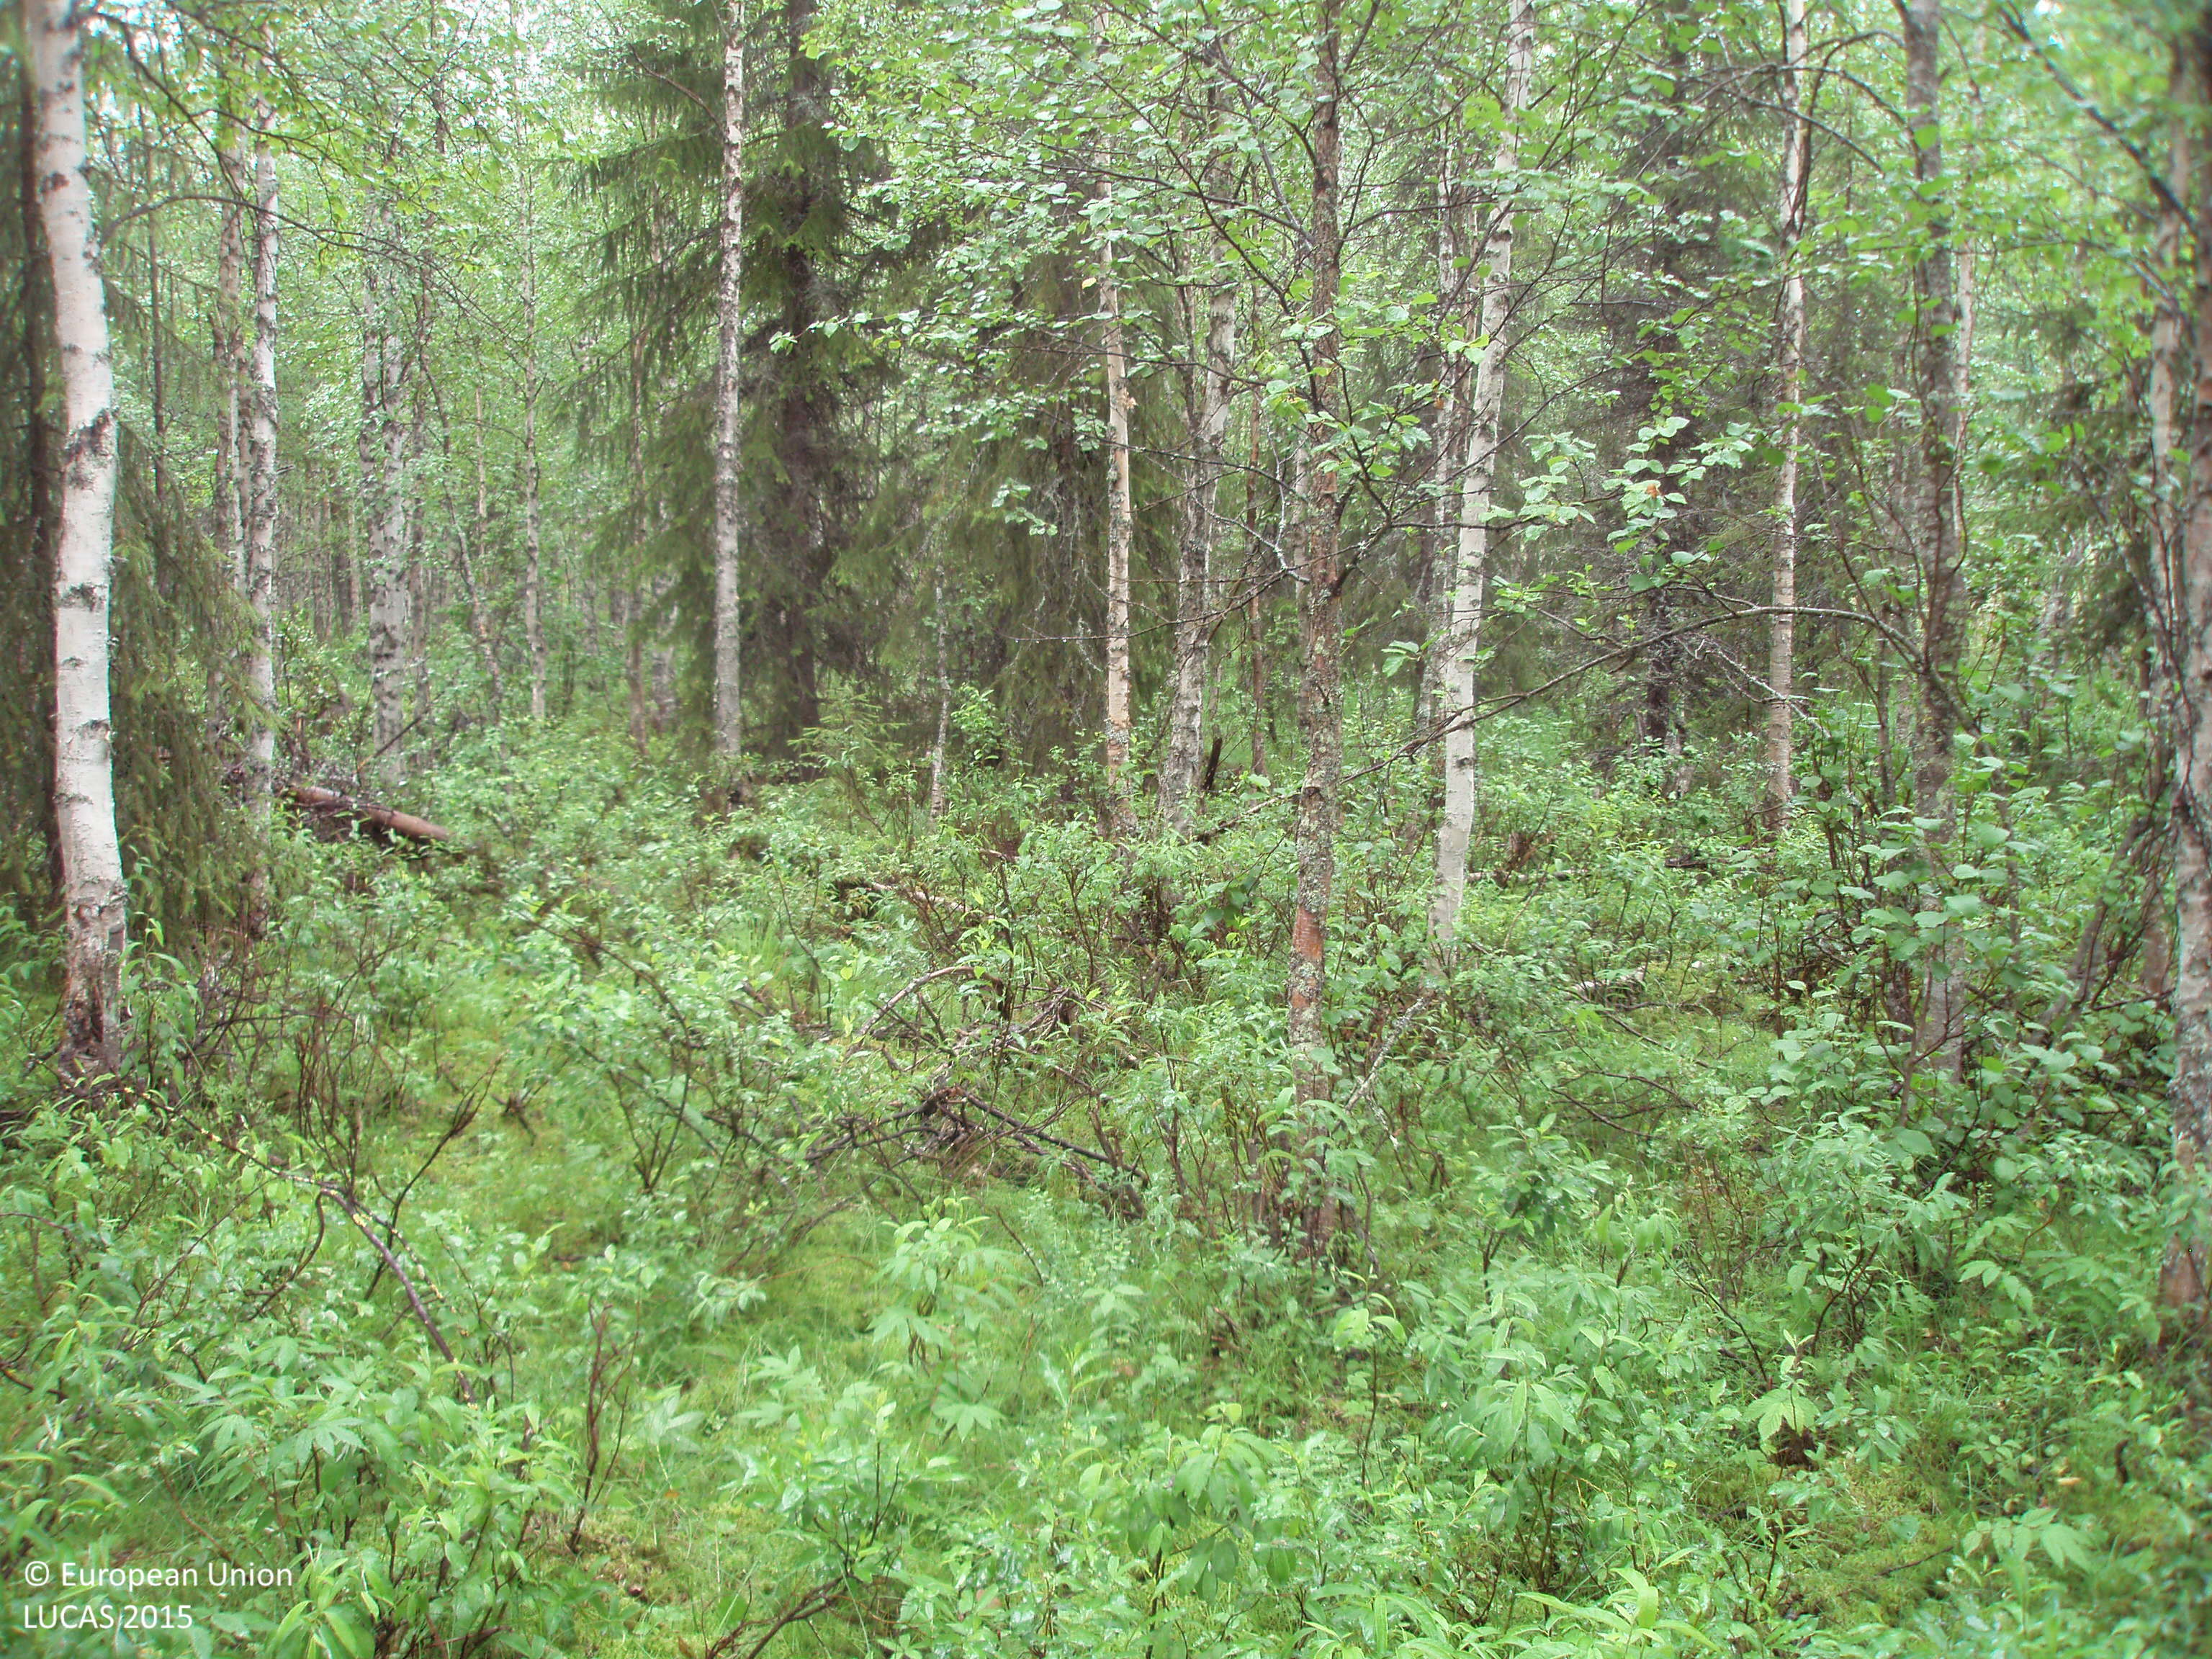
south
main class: Woodland
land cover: Pine dominated mixed woodland
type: boreal forest
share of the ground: > 75 %
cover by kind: broadleaved forest trees 55 %, coniferous forest trees 25 %, shrubs 20 %
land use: Forestry
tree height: > 5 m
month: July
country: FI
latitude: 66.7239
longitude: 27.9255
